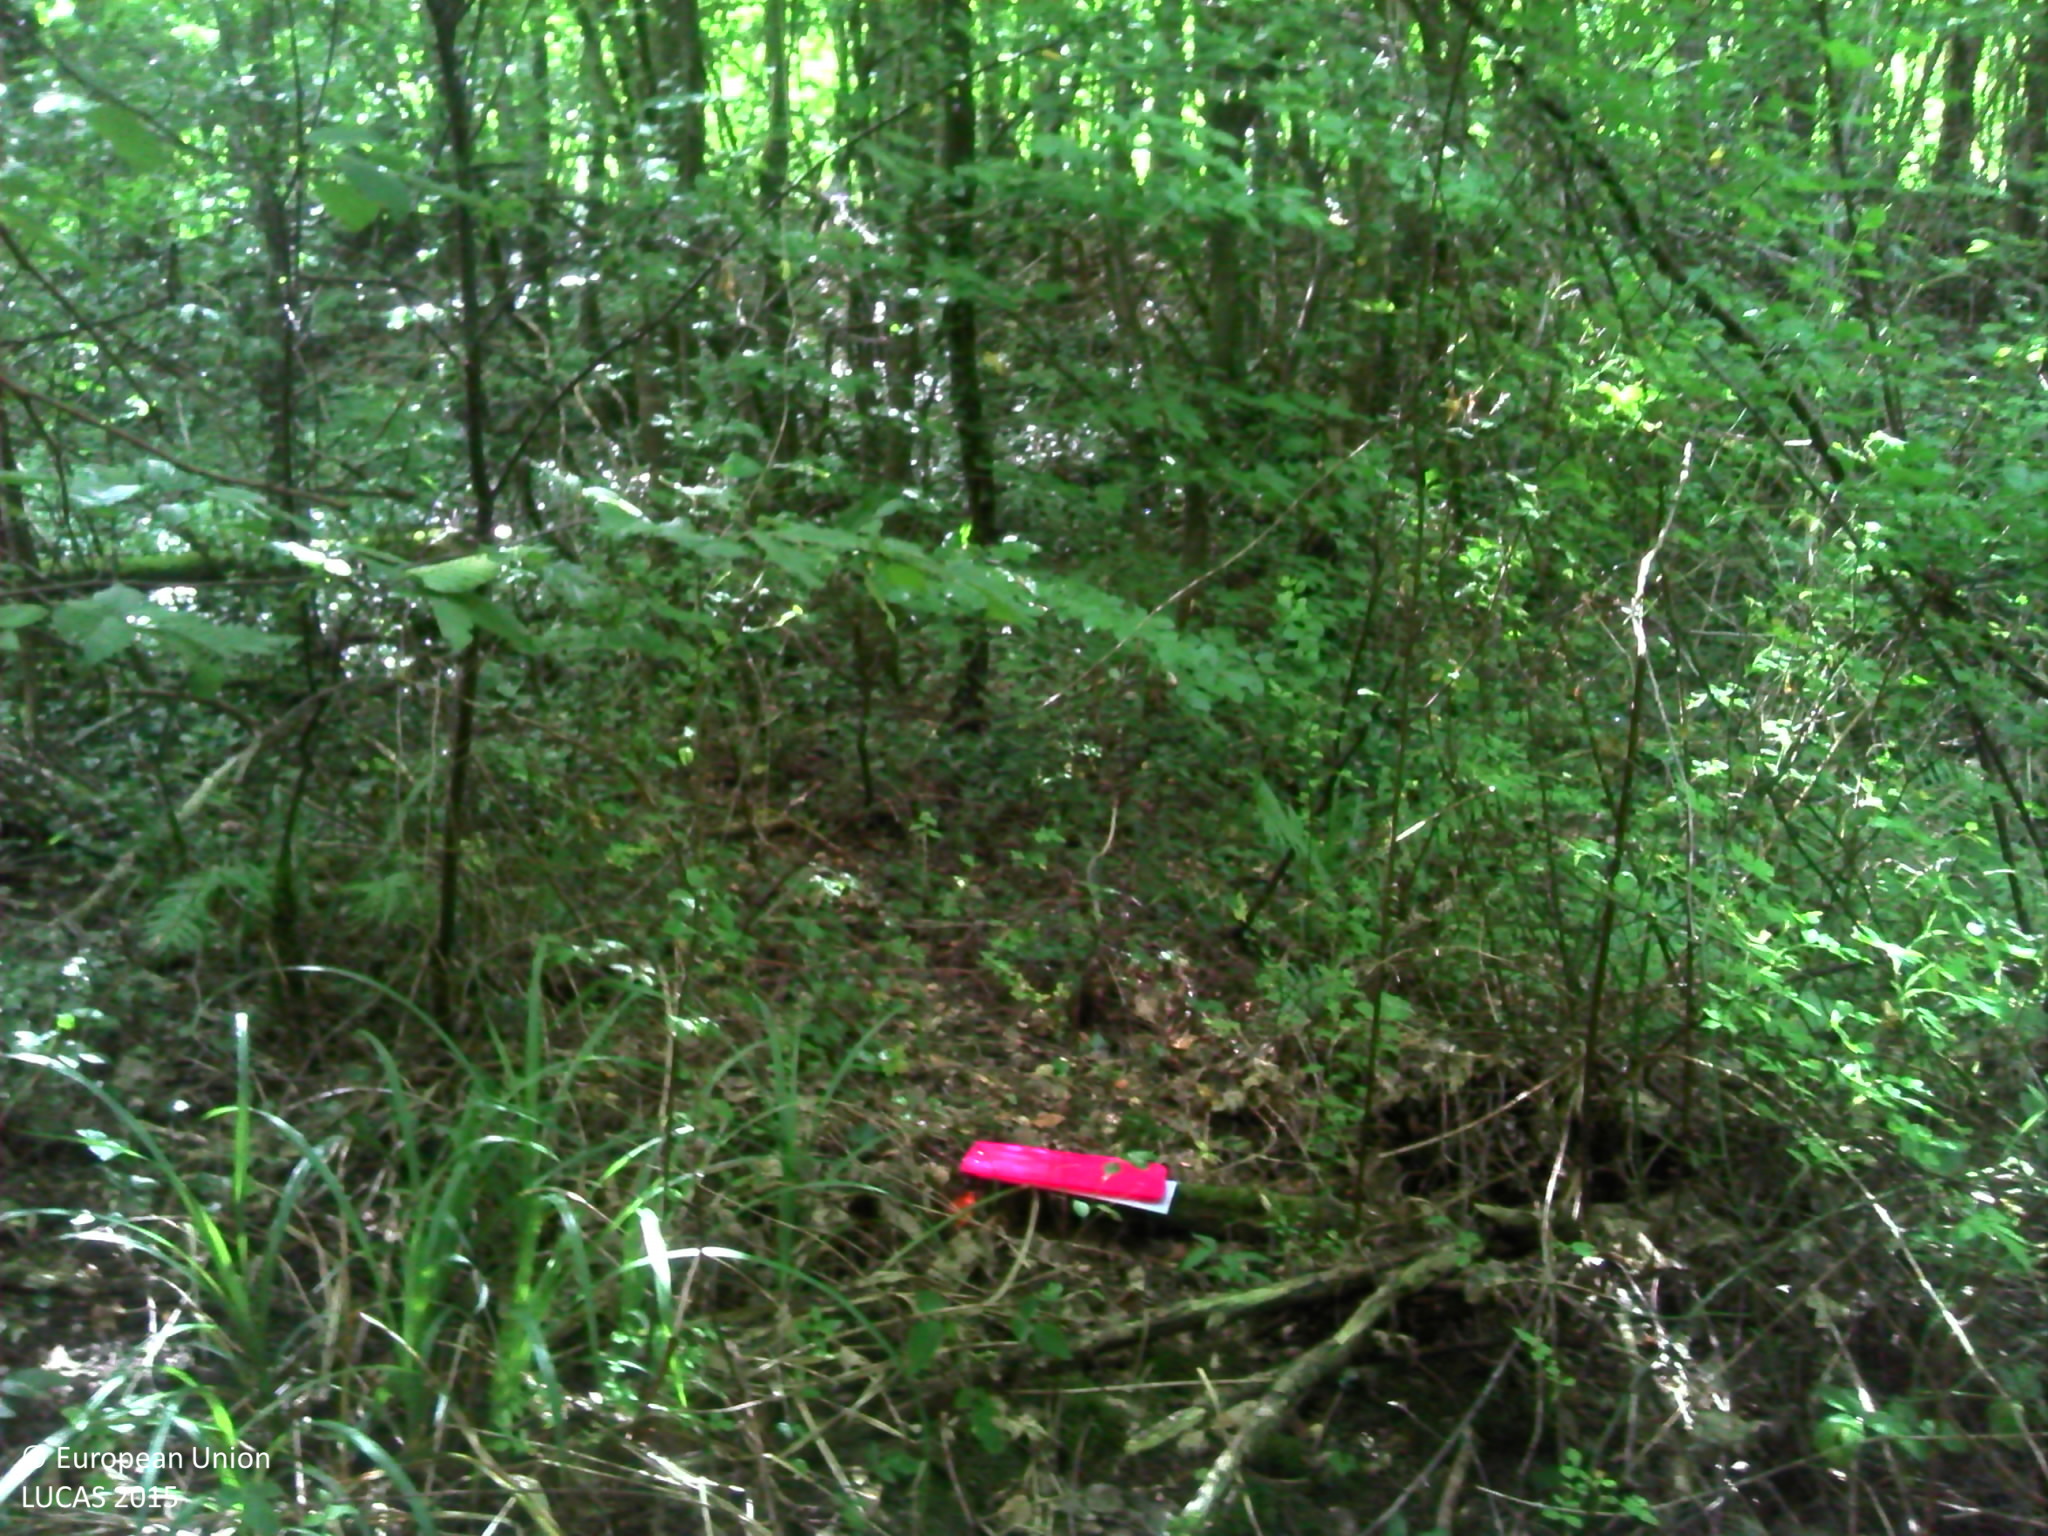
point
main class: Woodland
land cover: Broadleaved woodland
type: mesophytic deciduous forest
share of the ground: > 75 %
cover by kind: broadleaved forest trees 95 %, shrubs 5 %
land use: Forestry
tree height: > 5 m
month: June
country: FR
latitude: 48.8120
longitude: 4.9731
